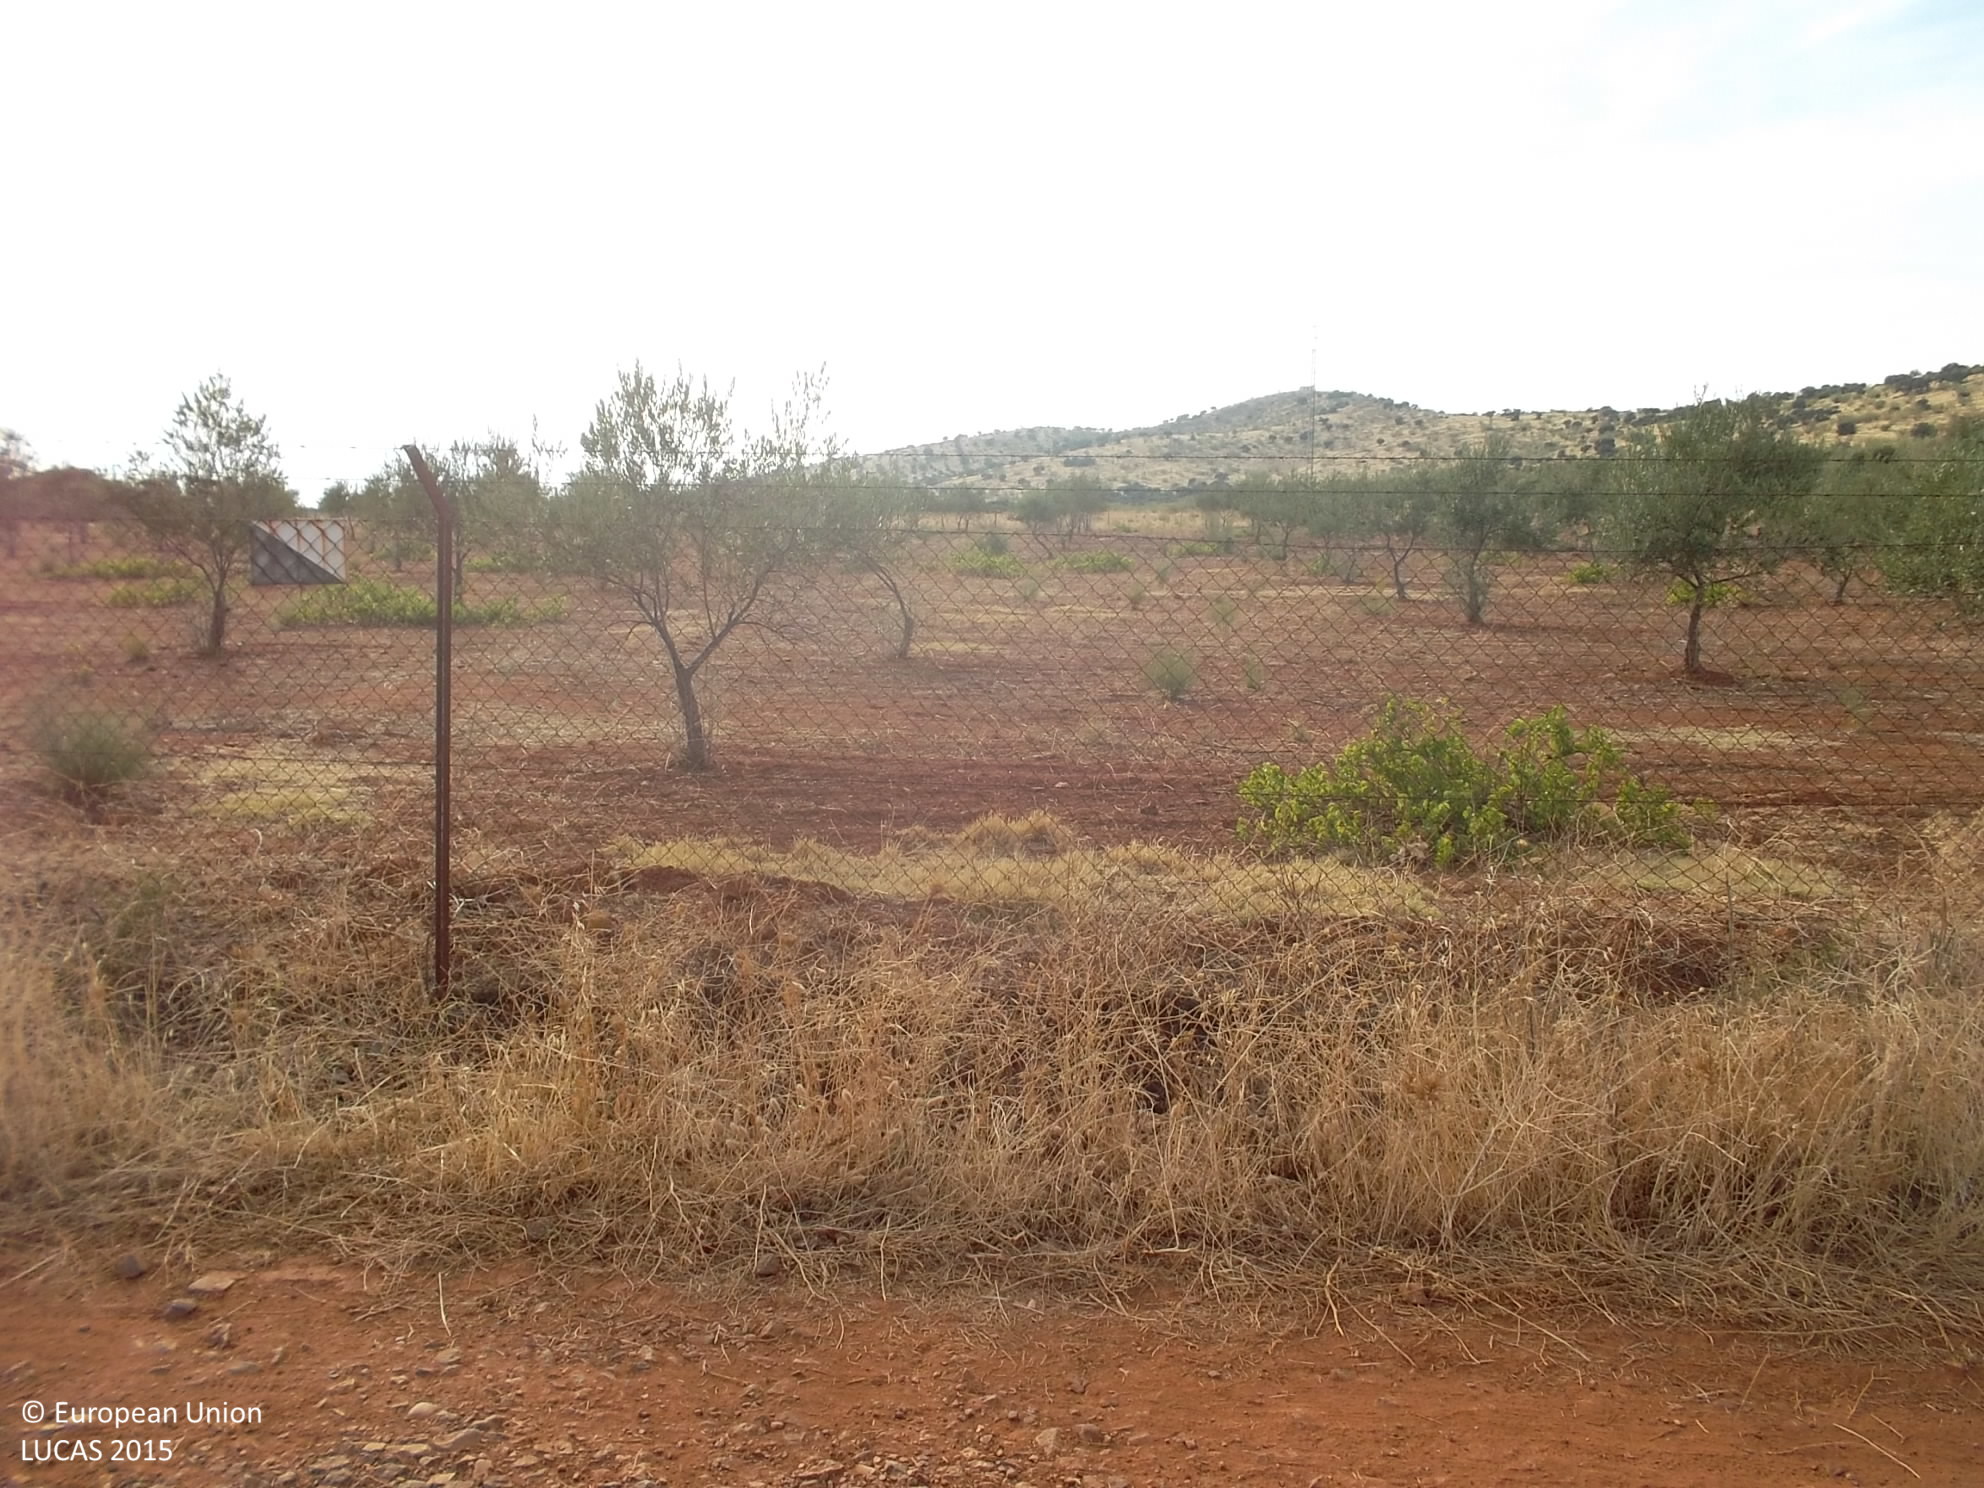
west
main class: Cropland
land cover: Olive groves
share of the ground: 10 - 25 %
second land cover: Grassland without tree/shrub cover
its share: > 75 %
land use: Agriculture (excluding fallow land and kitchen gardens)
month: September
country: ES
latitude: 38.4955
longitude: -6.3663
